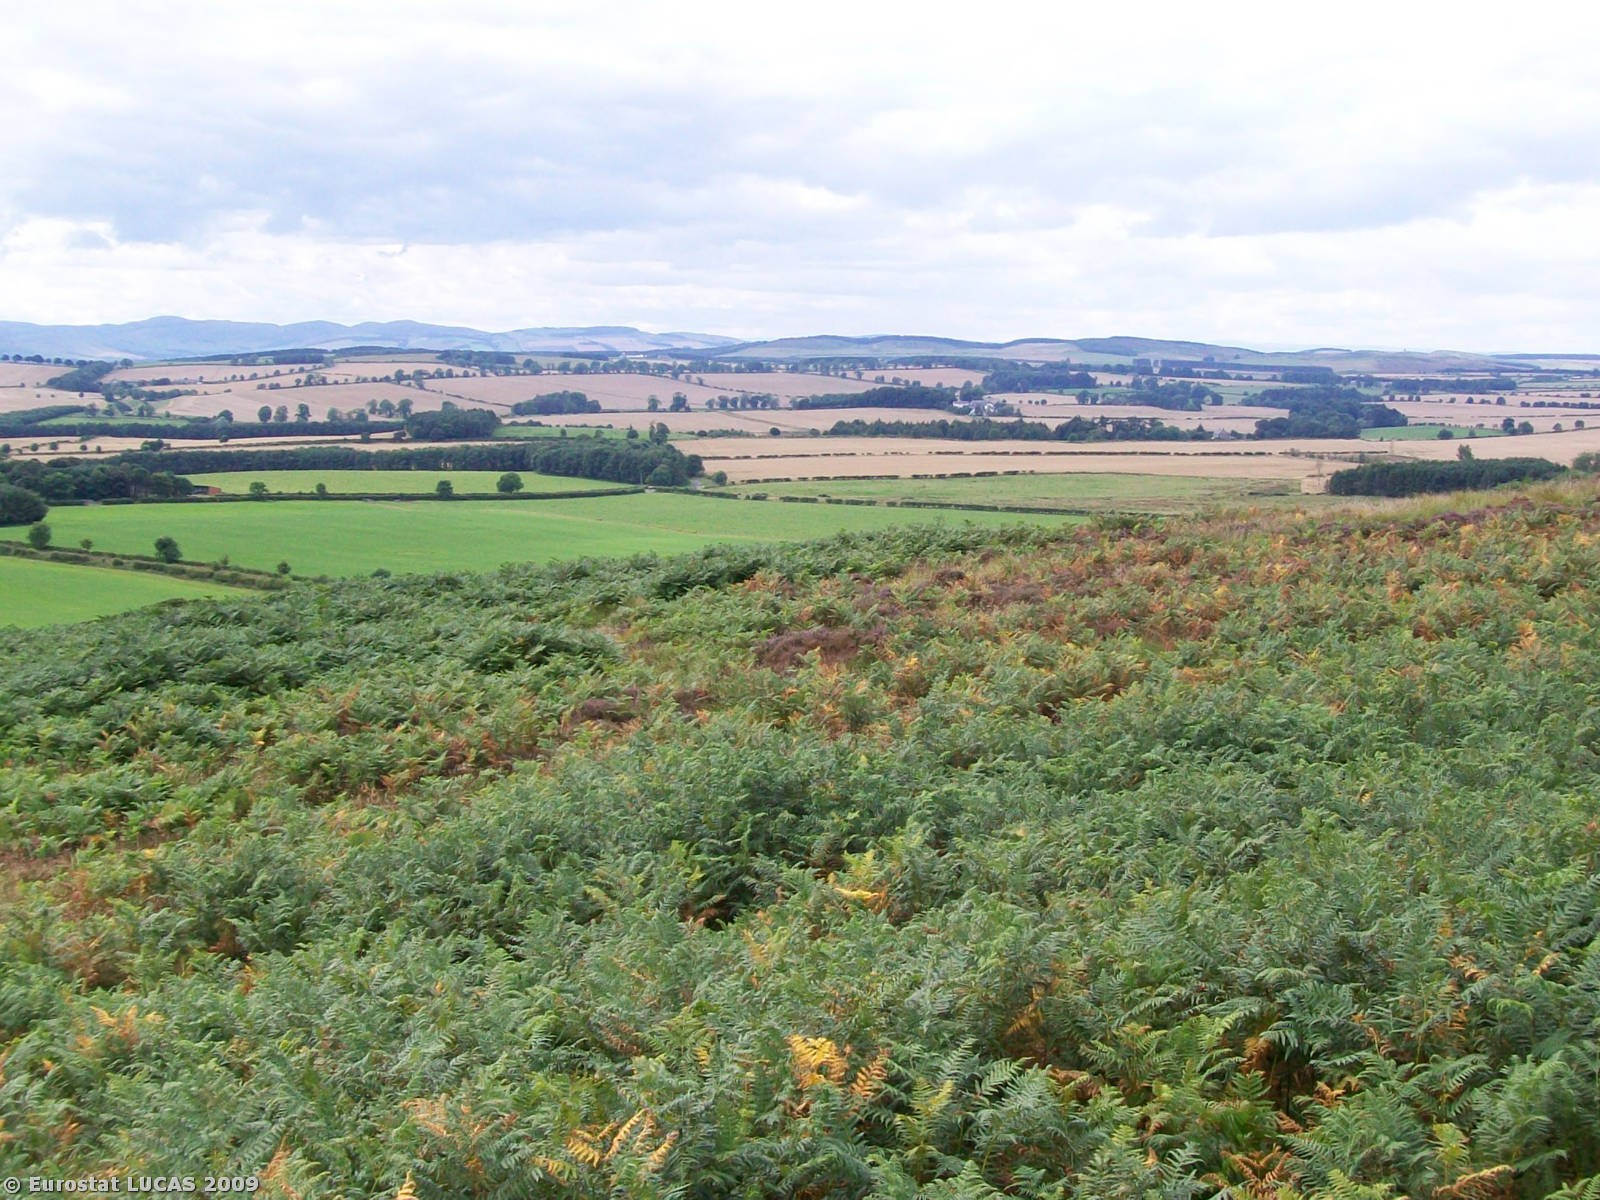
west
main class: Shrubland
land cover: Shrubland without tree cover
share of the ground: > 75 %
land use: Agriculture (excluding fallow land and kitchen gardens)
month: August
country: GB
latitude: 55.6125
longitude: -1.9107
